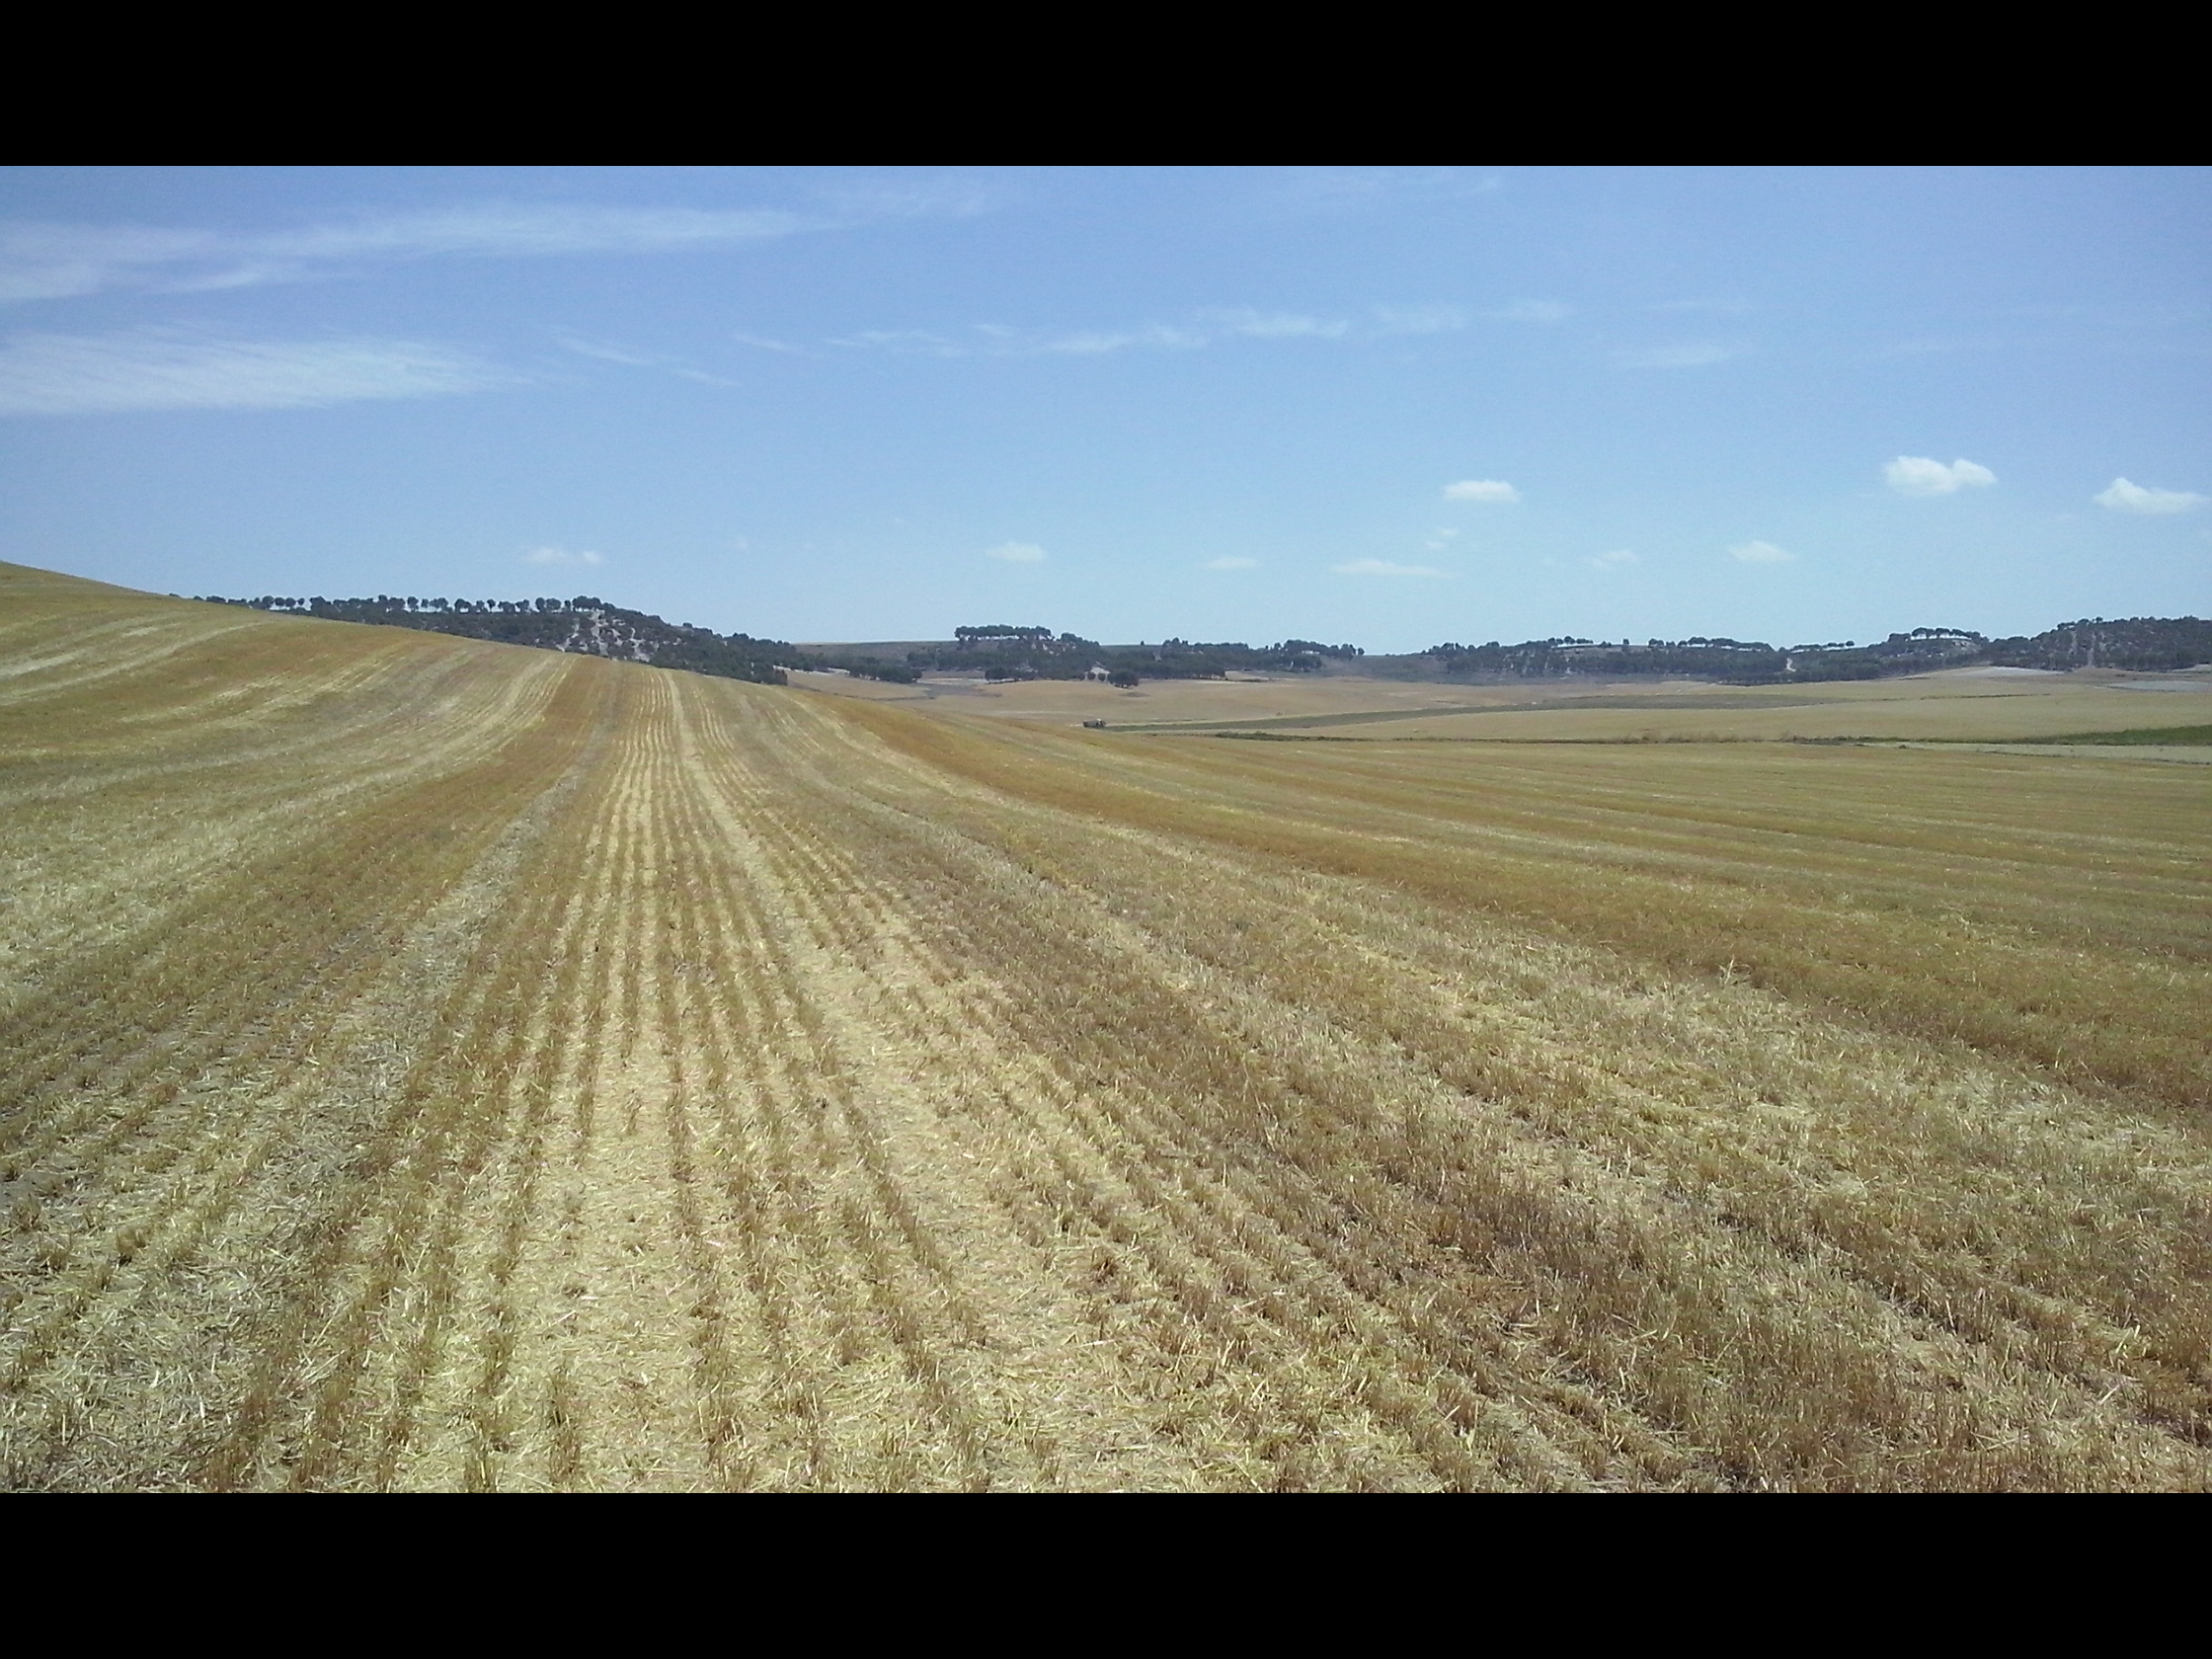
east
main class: Cropland
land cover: Barley
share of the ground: < 10 %
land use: Agriculture (excluding fallow land and kitchen gardens)
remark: Harvested field
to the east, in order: Barley
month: July
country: ES
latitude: 41.5870
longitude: -5.1055
